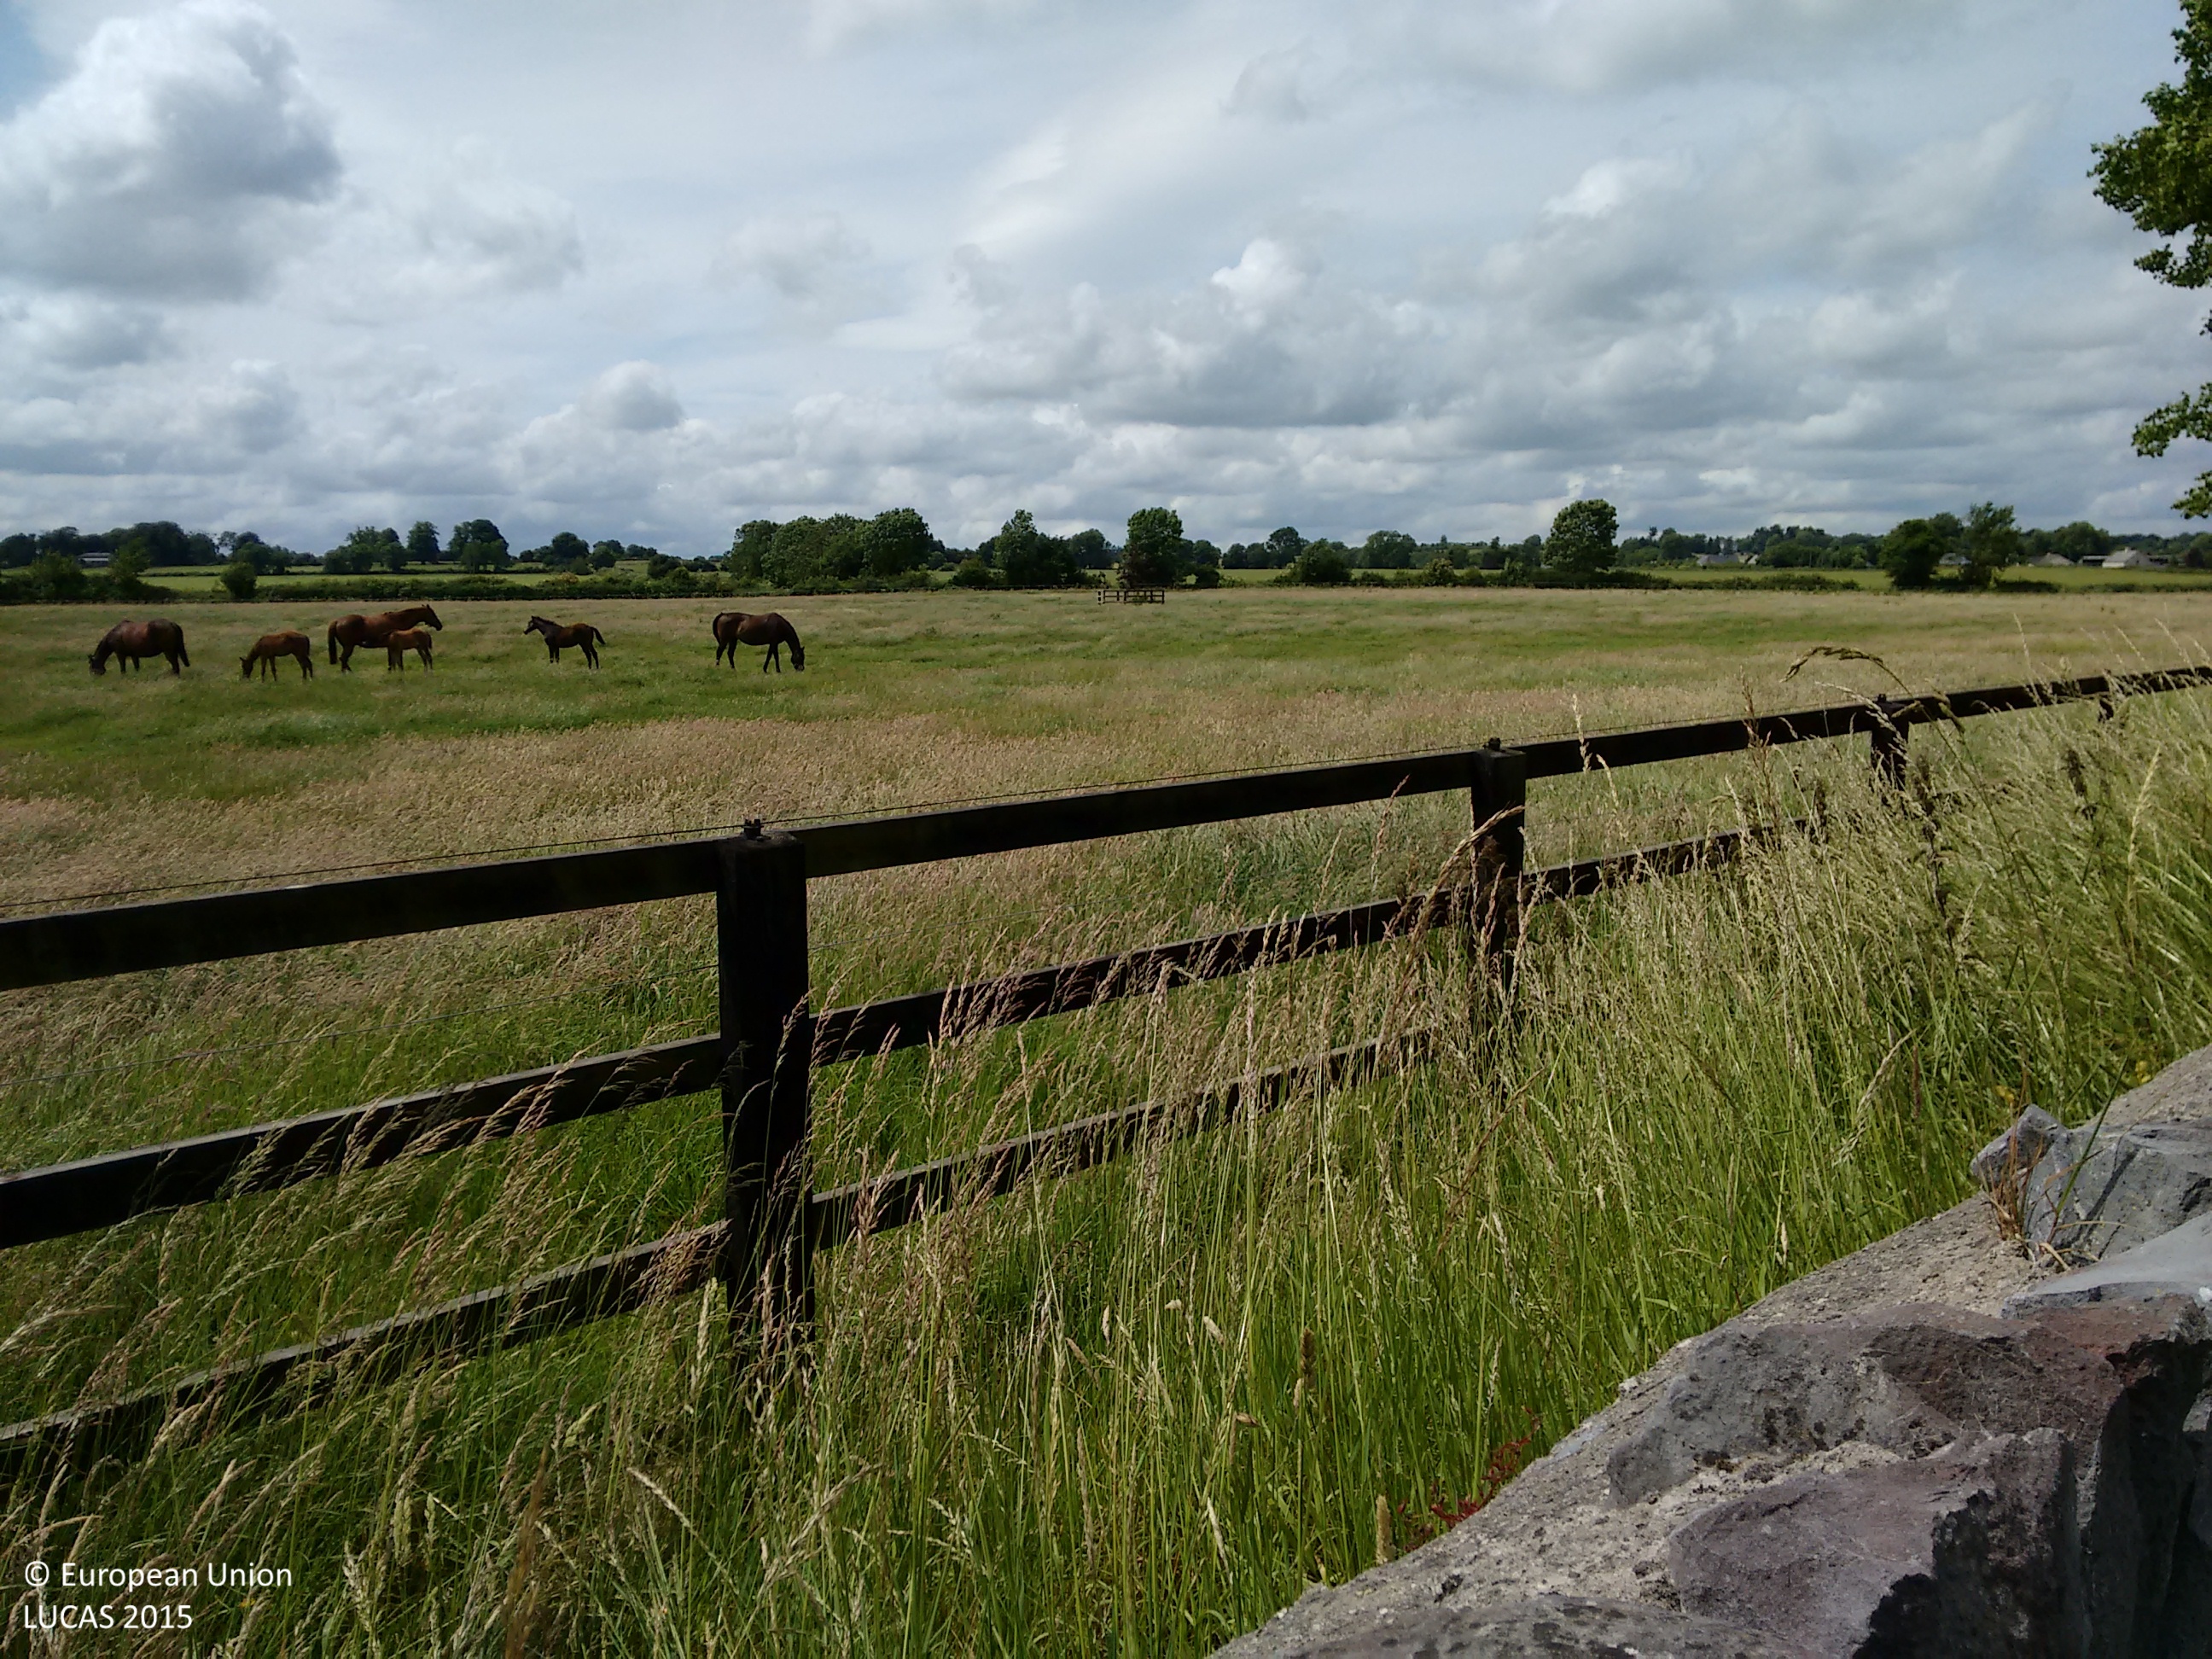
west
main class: Grassland
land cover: Grassland without tree/shrub cover
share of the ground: > 75 %
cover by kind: herbaceous plants 100 %
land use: Agriculture (excluding fallow land and kitchen gardens)
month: July
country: IE
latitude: 52.4828
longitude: -7.7338
